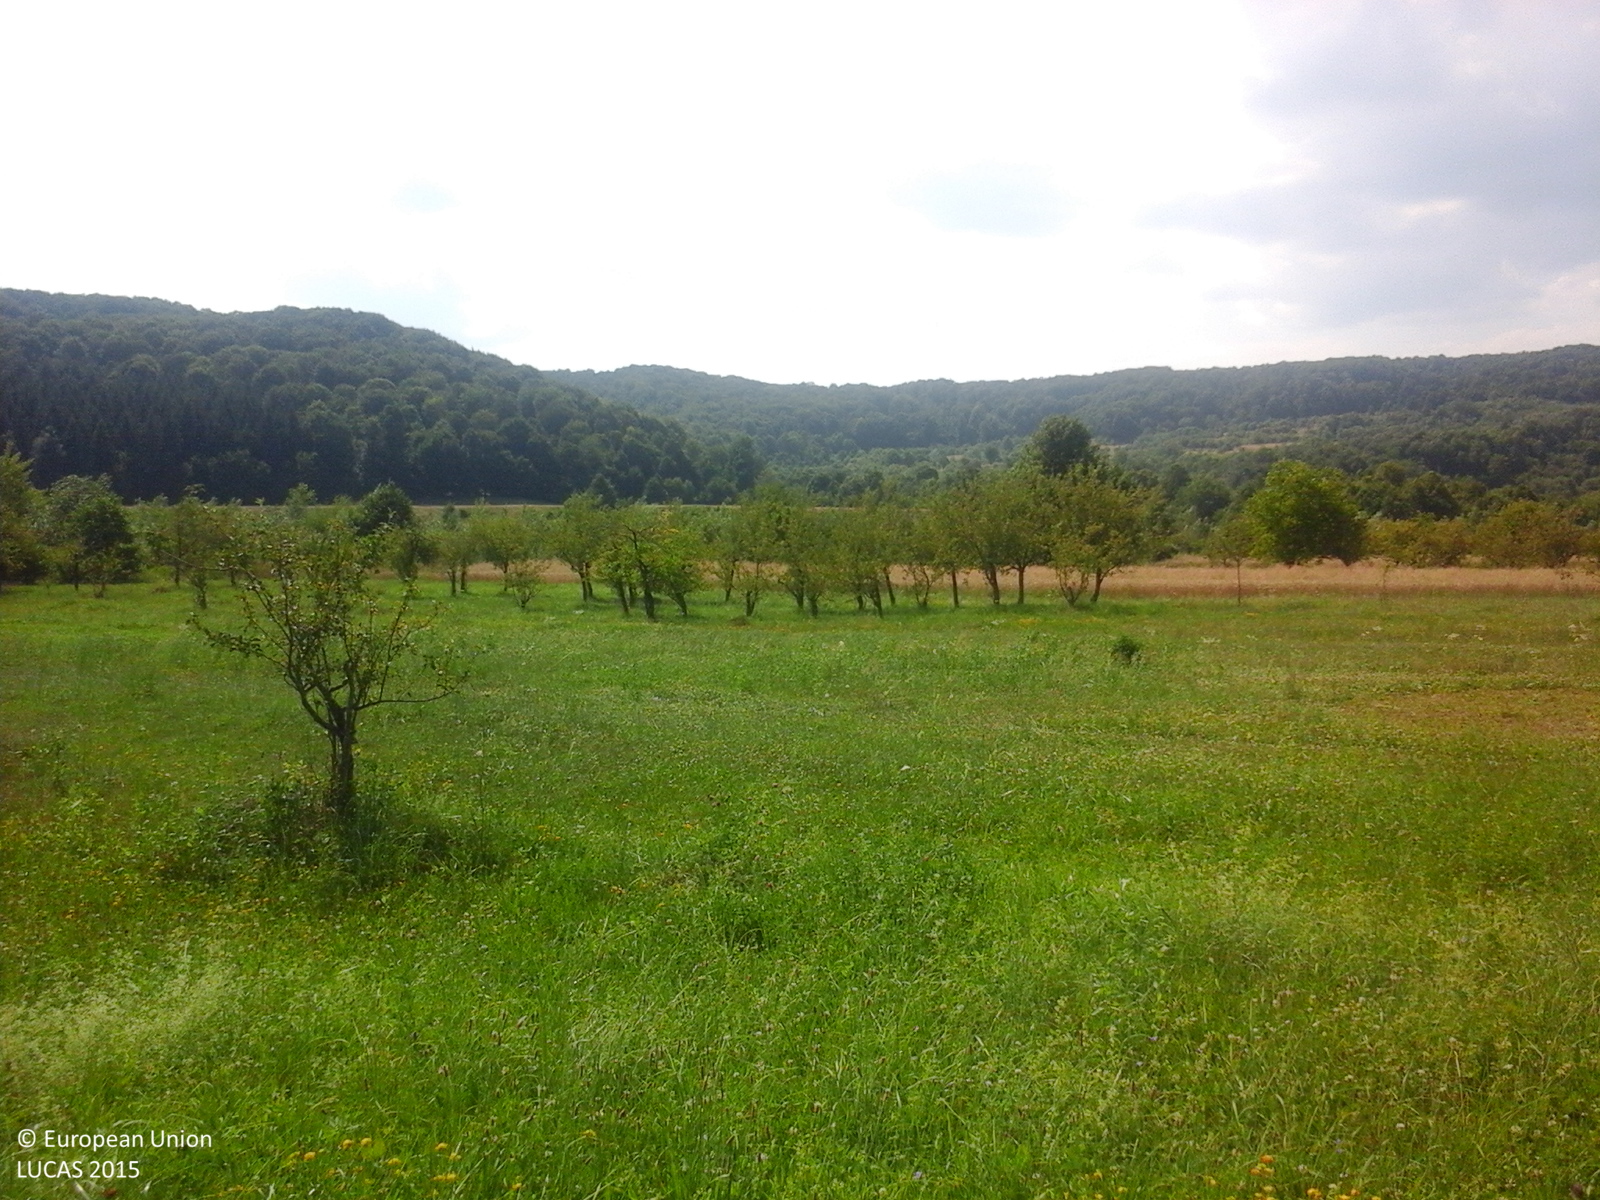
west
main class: Cropland
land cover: Lucerne
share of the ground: > 75 %
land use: Agriculture (excluding fallow land and kitchen gardens)
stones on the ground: < 10 %
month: July
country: RO
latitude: 45.1602
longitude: 24.9833
